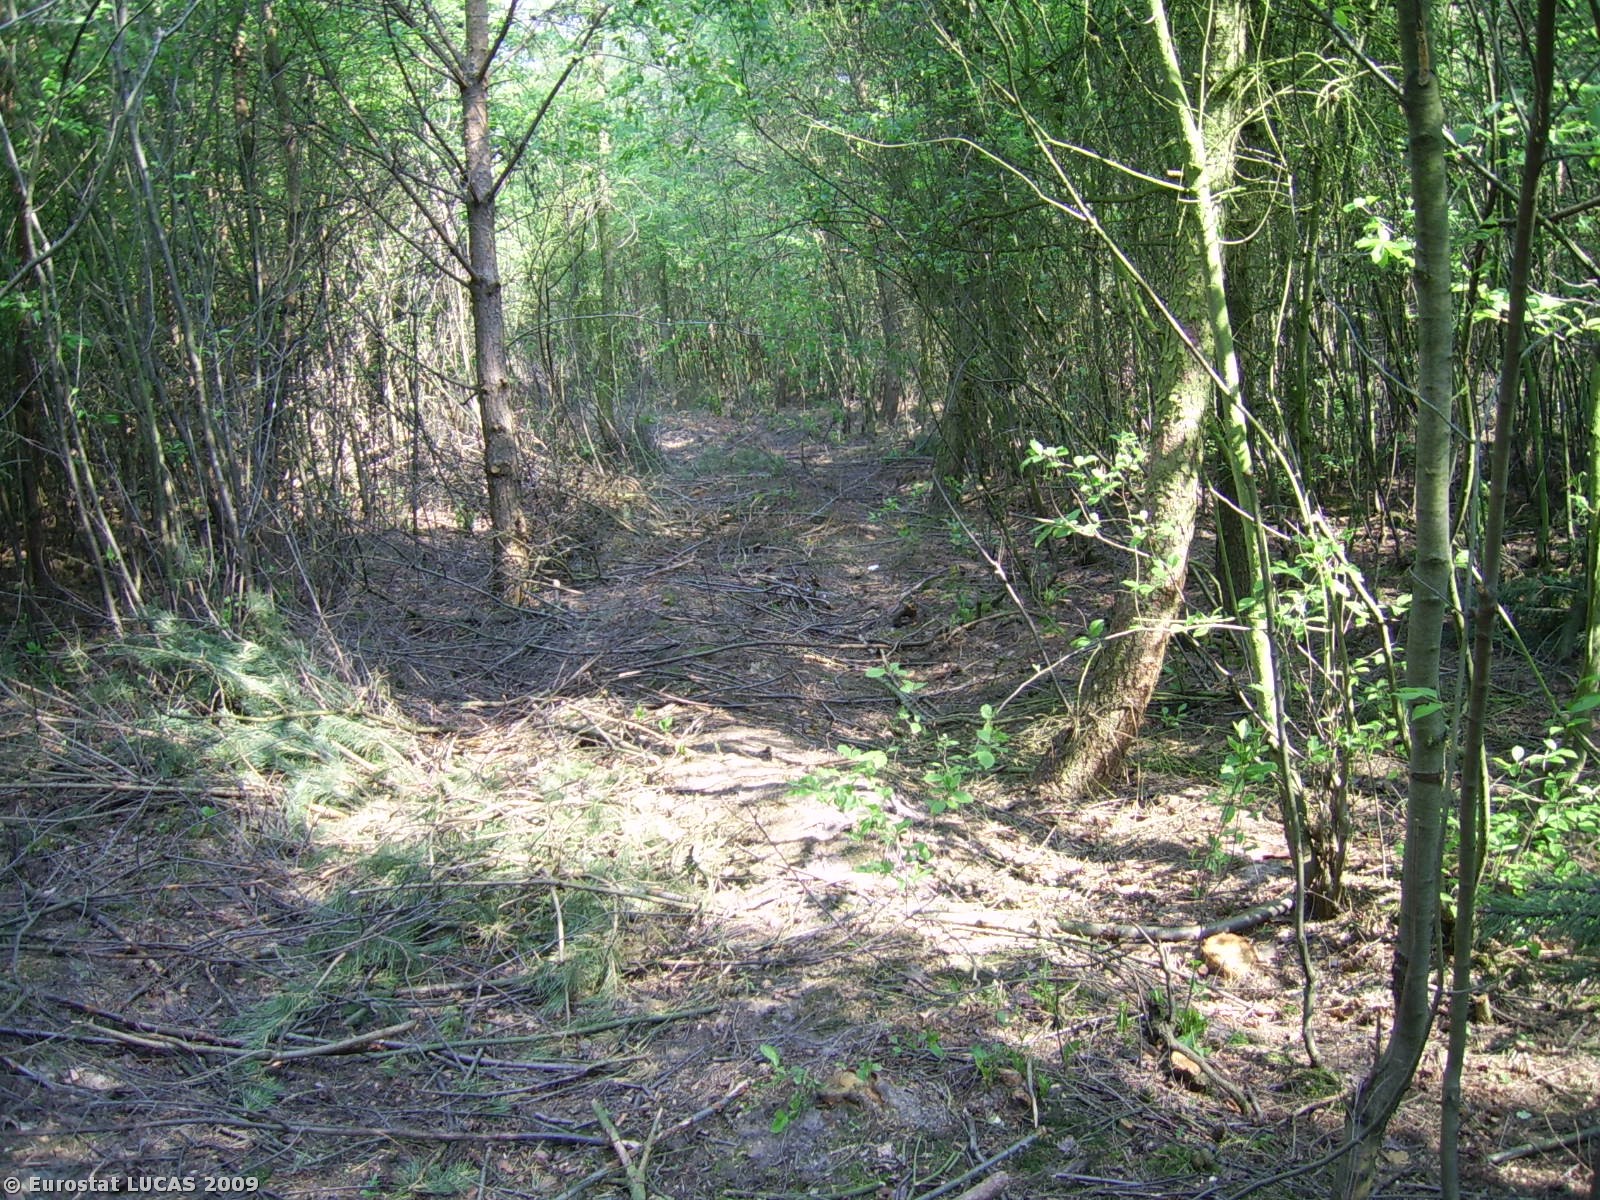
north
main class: Woodland
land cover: Mixed woodland
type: hemiboreal forest and nemoral coniferous forest and mixed broadleaved-coniferous forest
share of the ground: > 75 %
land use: Forestry
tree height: > 5 m
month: April
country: PL
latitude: 52.0500
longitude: 16.9068
